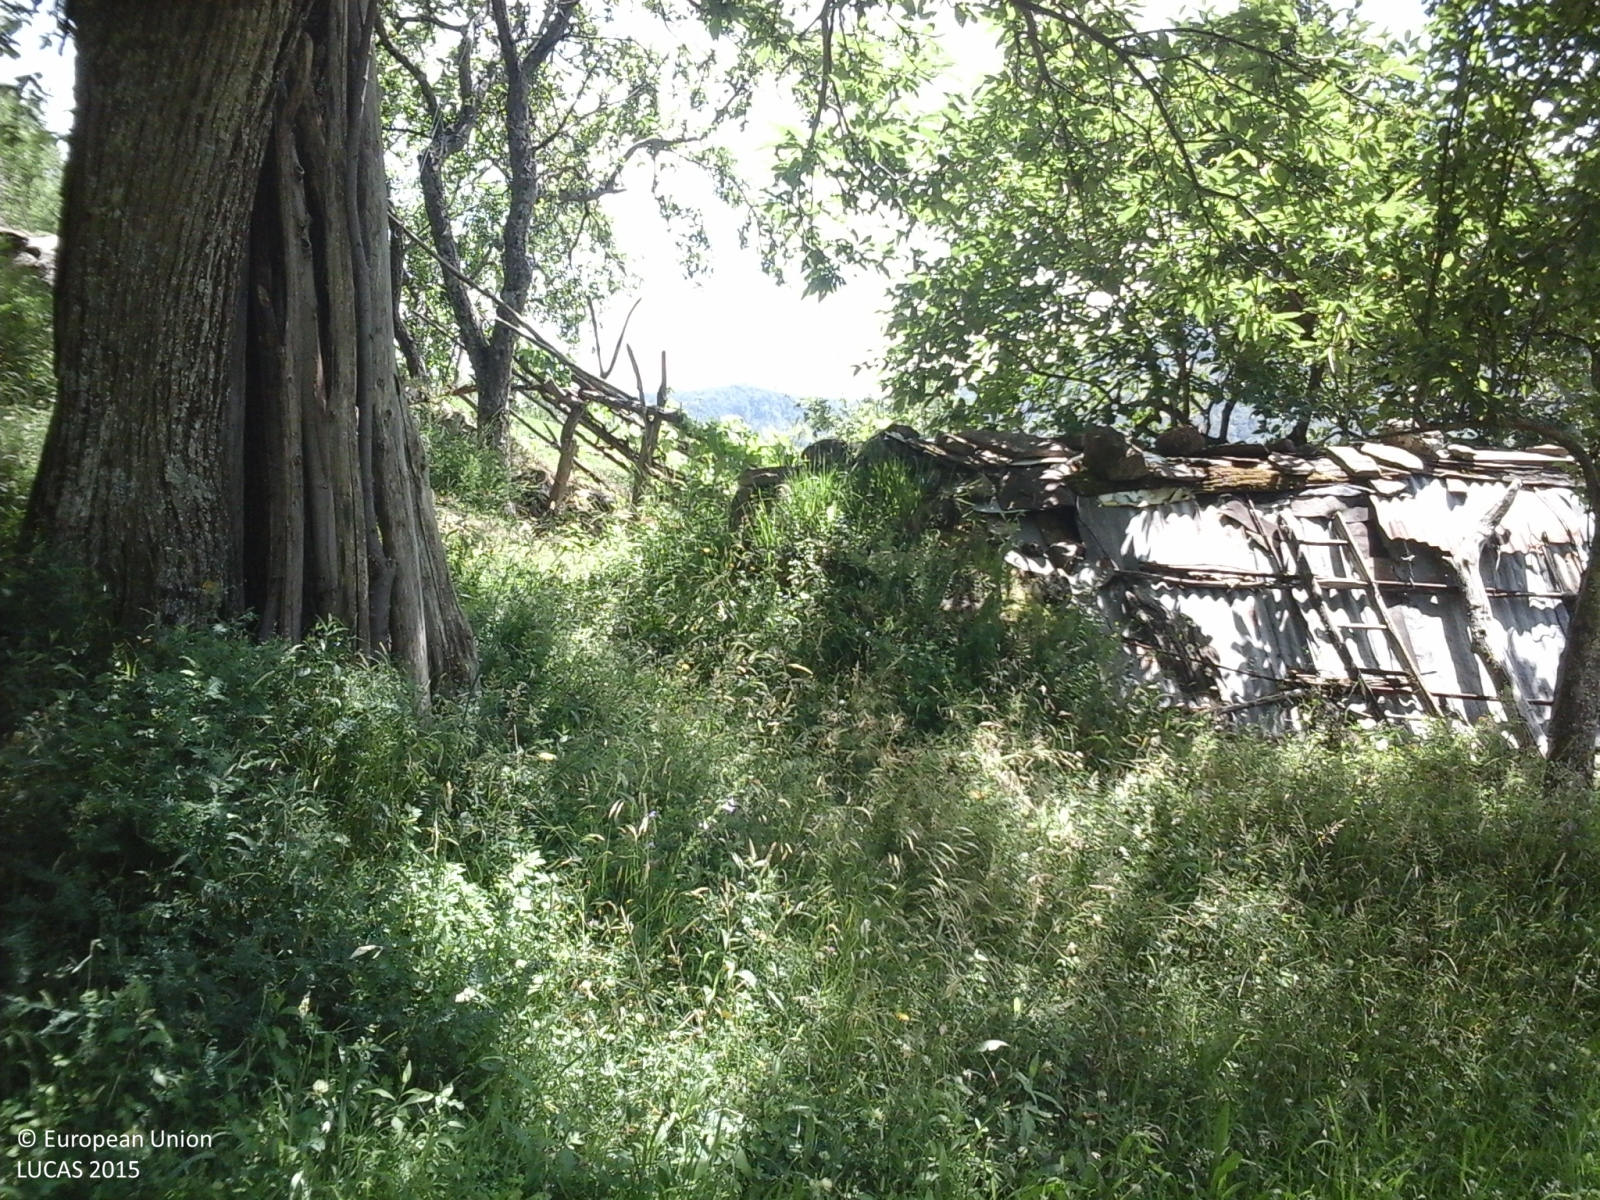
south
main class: Grassland
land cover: Spontaneously vegetated surfaces
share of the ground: > 75 %
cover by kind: herbaceous plants 100 %
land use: Semi-natural and natural areas not in use
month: June
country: IT
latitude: 42.8146
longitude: 13.3779
